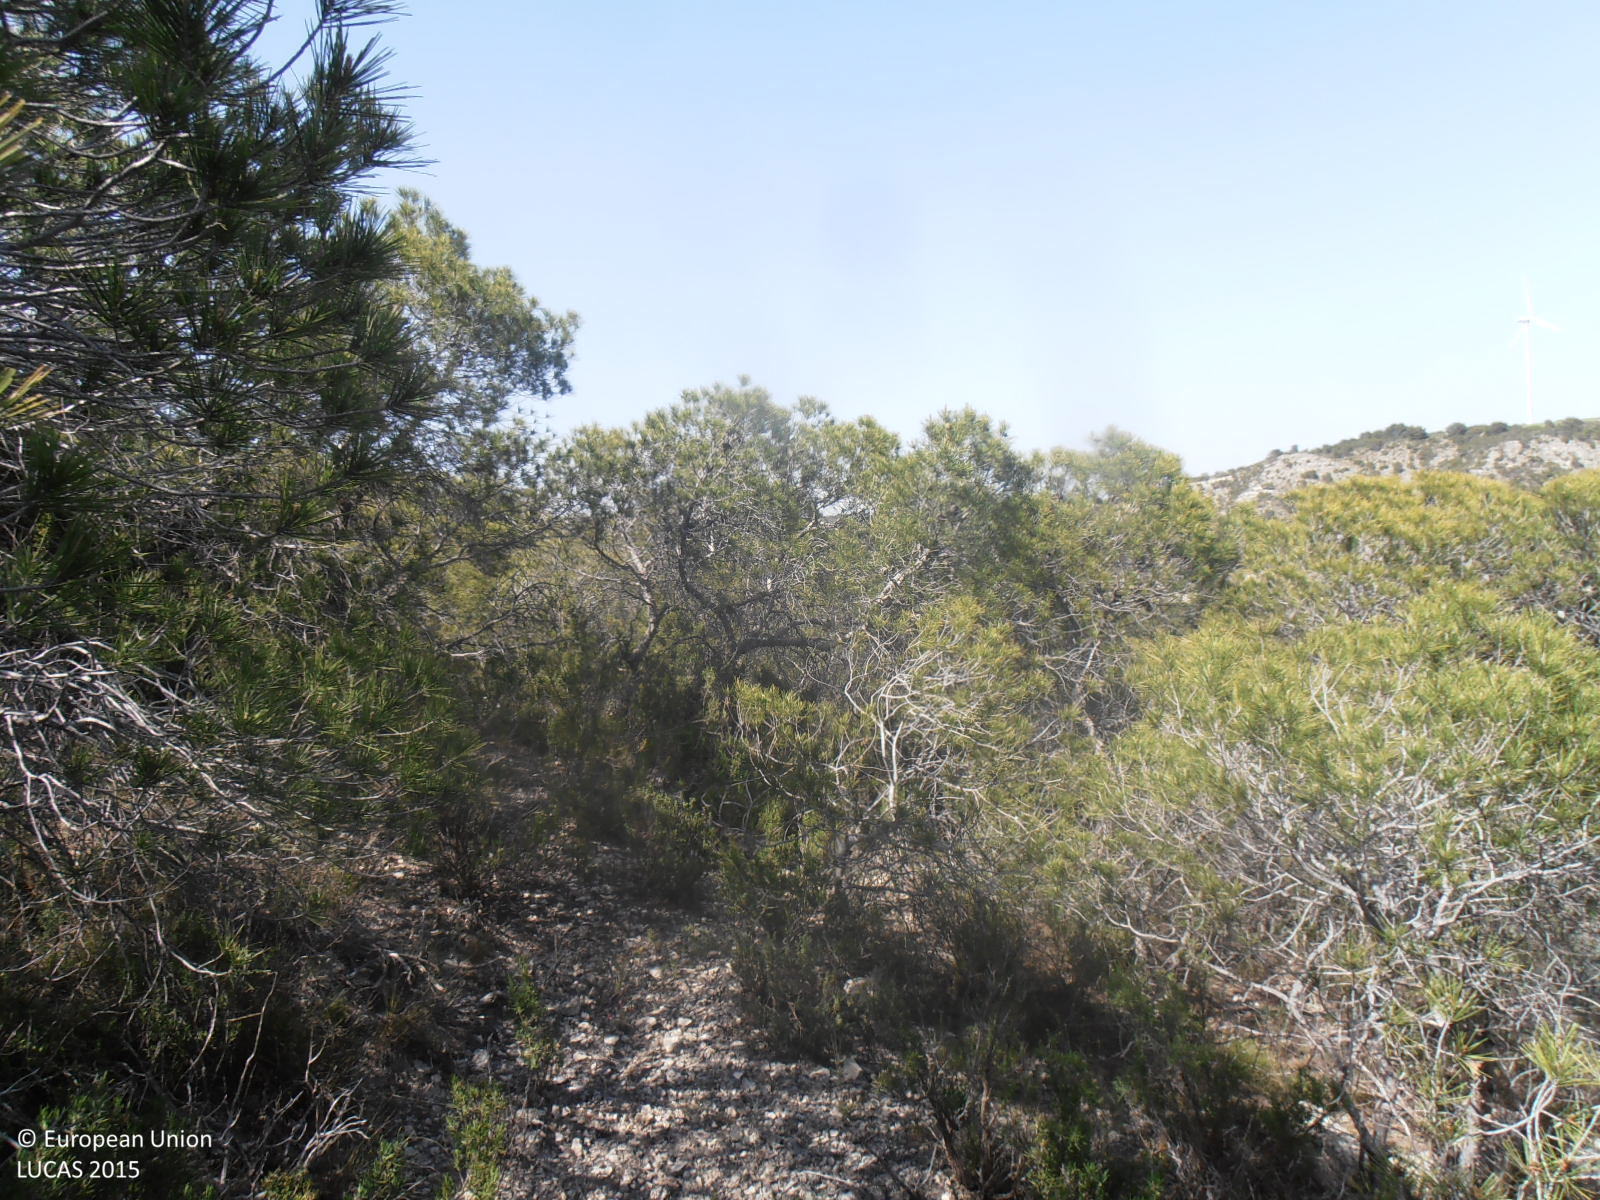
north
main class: Woodland
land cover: Pine dominated coniferous woodland
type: coniferous forest of the mediterranean region
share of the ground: 50 - 75 %
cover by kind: coniferous forest trees 80 %, shrubs 10 %, consolidated bare surface 10 %
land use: Forestry
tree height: > 5 m
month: May
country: ES
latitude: 41.4931
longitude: -0.9570
